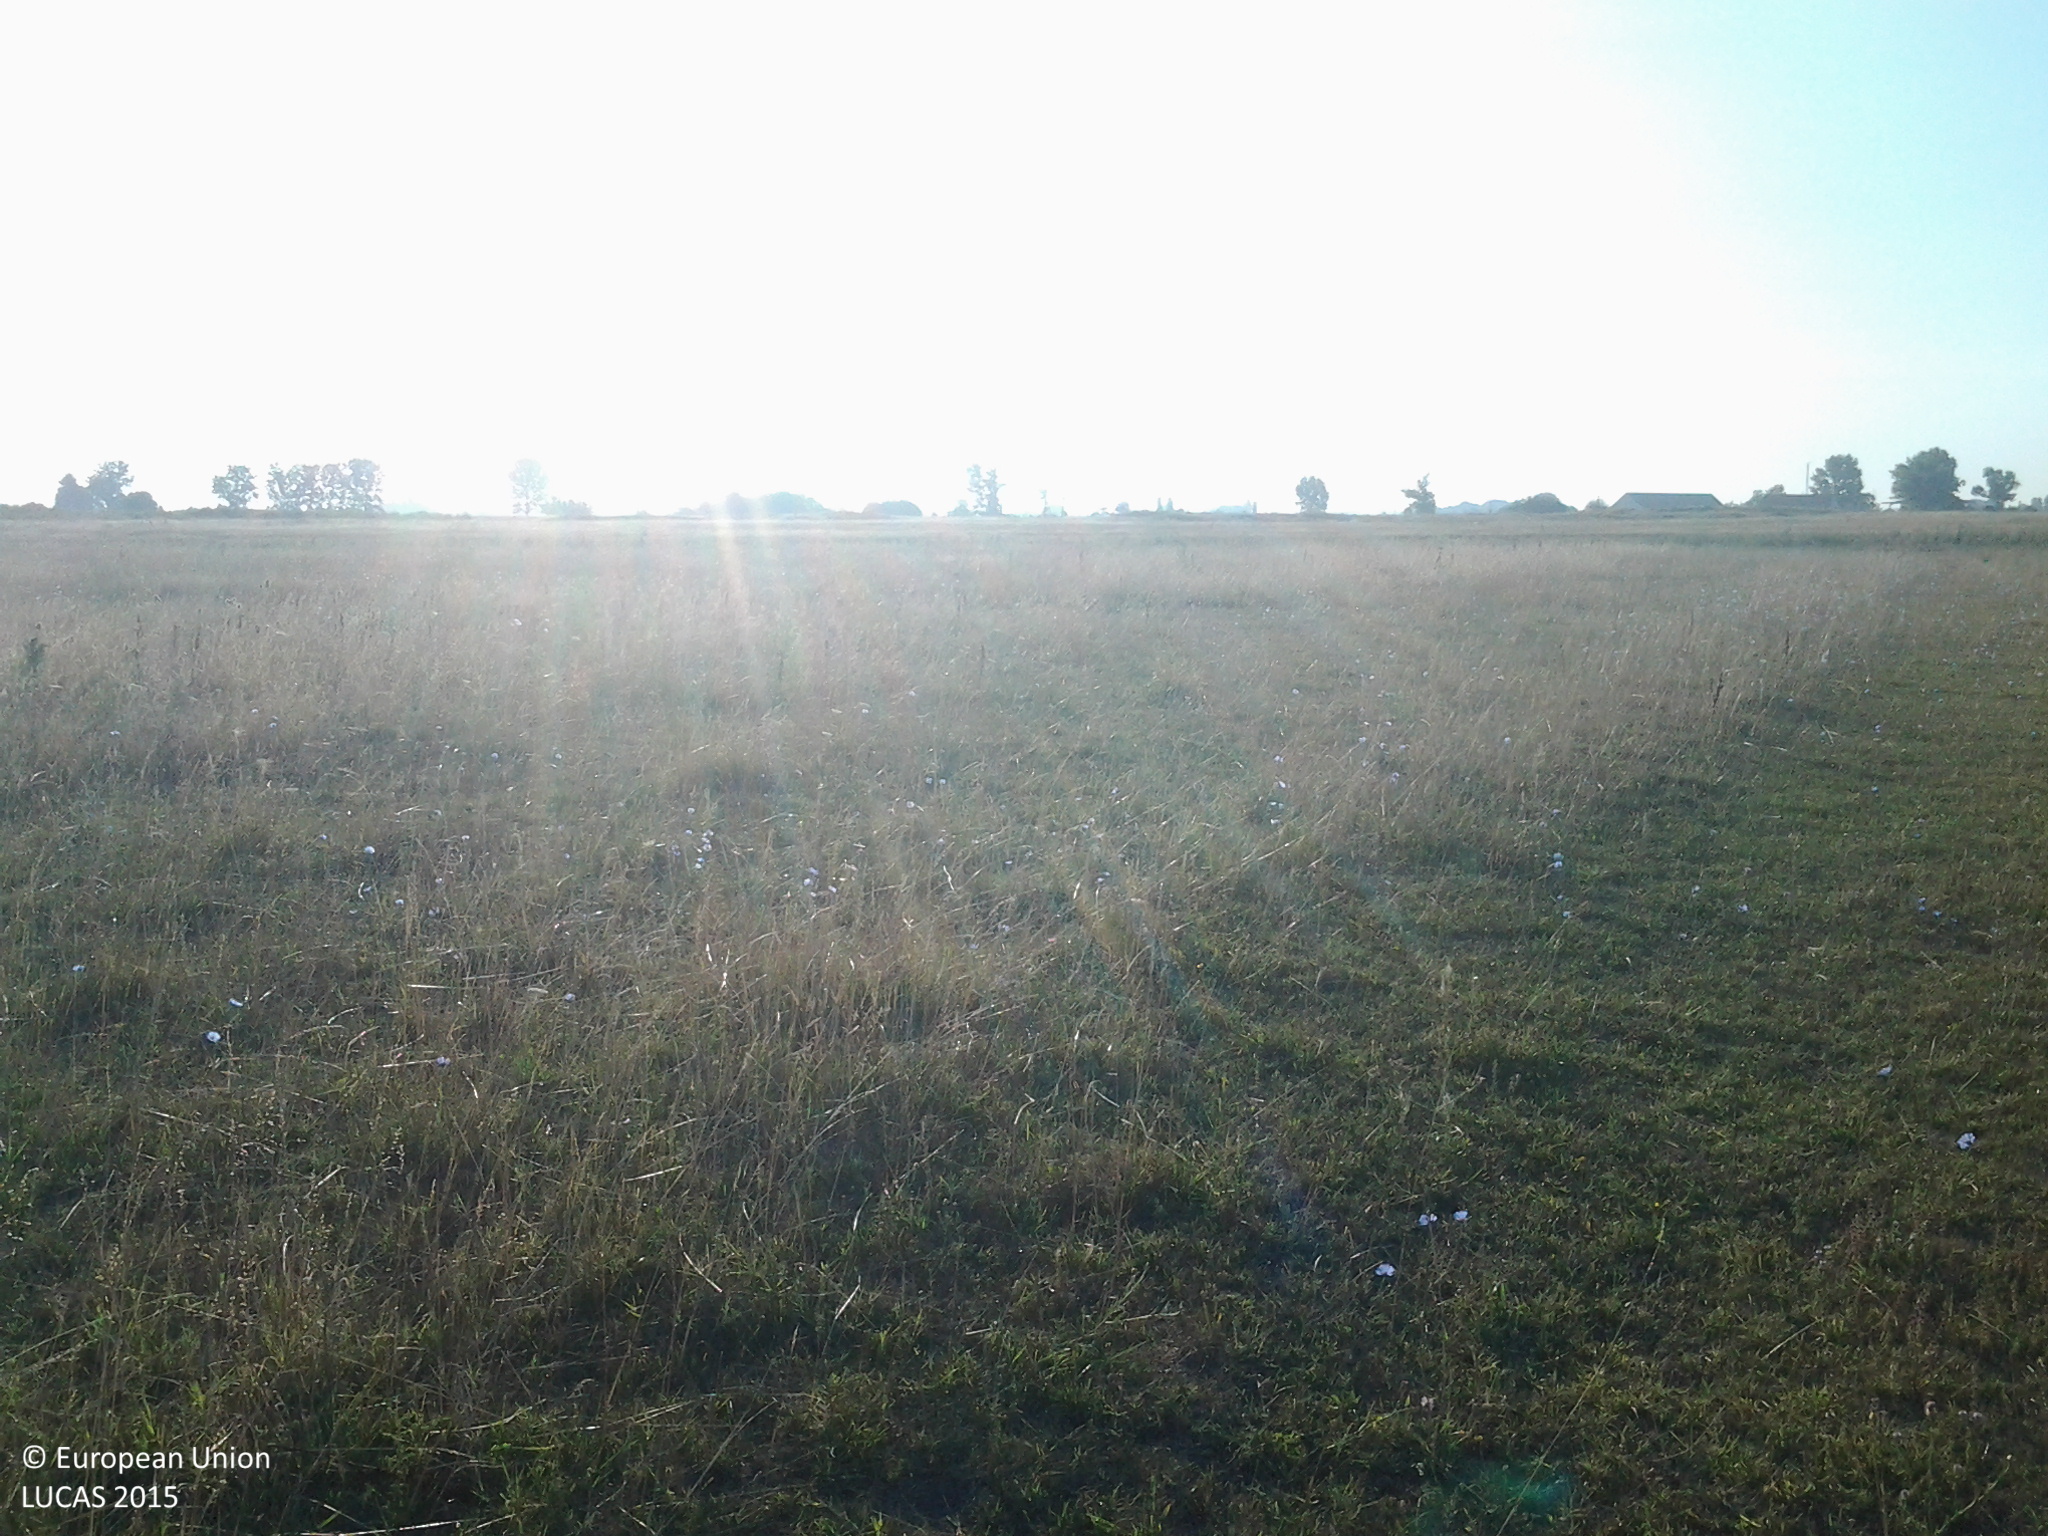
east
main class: Grassland
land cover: Grassland without tree/shrub cover
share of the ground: > 75 %
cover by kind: herbaceous plants 100 %
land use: Agriculture (excluding fallow land and kitchen gardens)
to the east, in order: Grassland without tree/shrub cover; Spontaneously vegetated surfaces; Grassland without tree/shrub cover; Ditches and canals; Grassland without tree/shrub cover
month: July
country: HU
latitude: 46.7676
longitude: 19.2218
